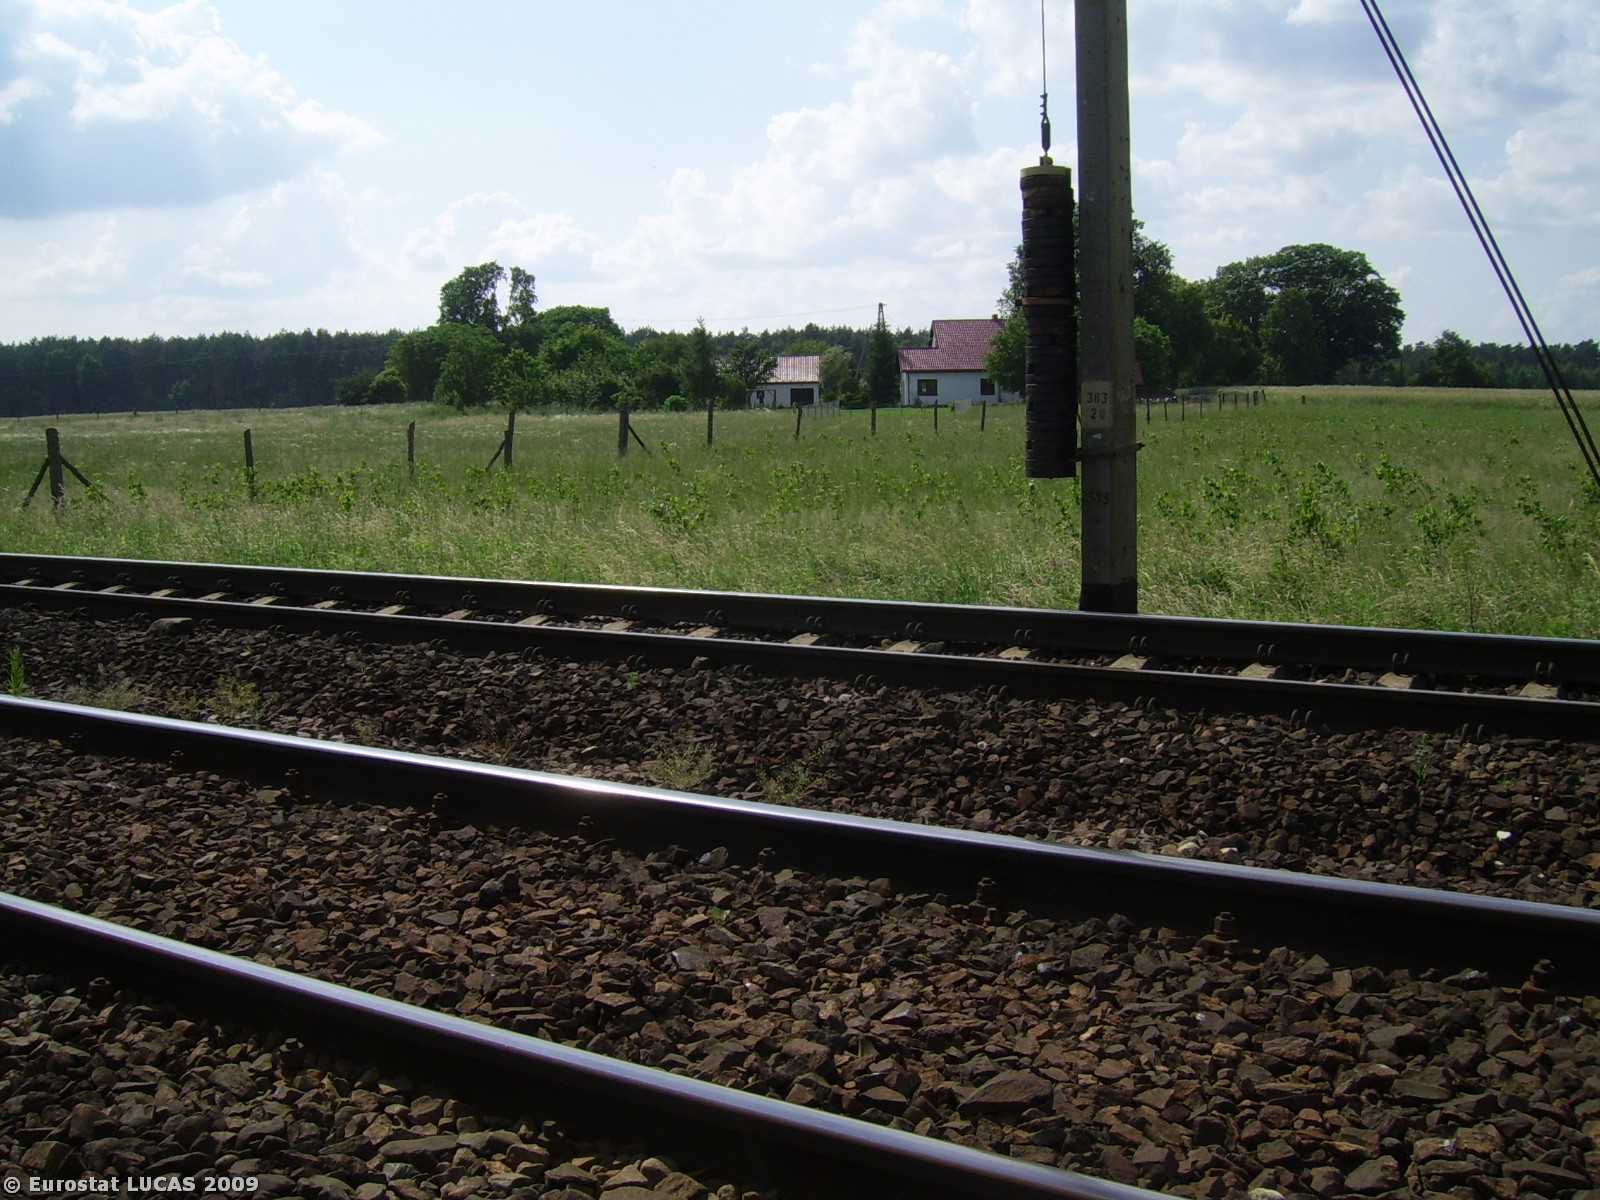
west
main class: Woodland
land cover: Broadleaved woodland
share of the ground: > 75 %
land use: Forestry
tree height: < 5 m
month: July
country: PL
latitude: 53.2413
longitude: 18.0620
